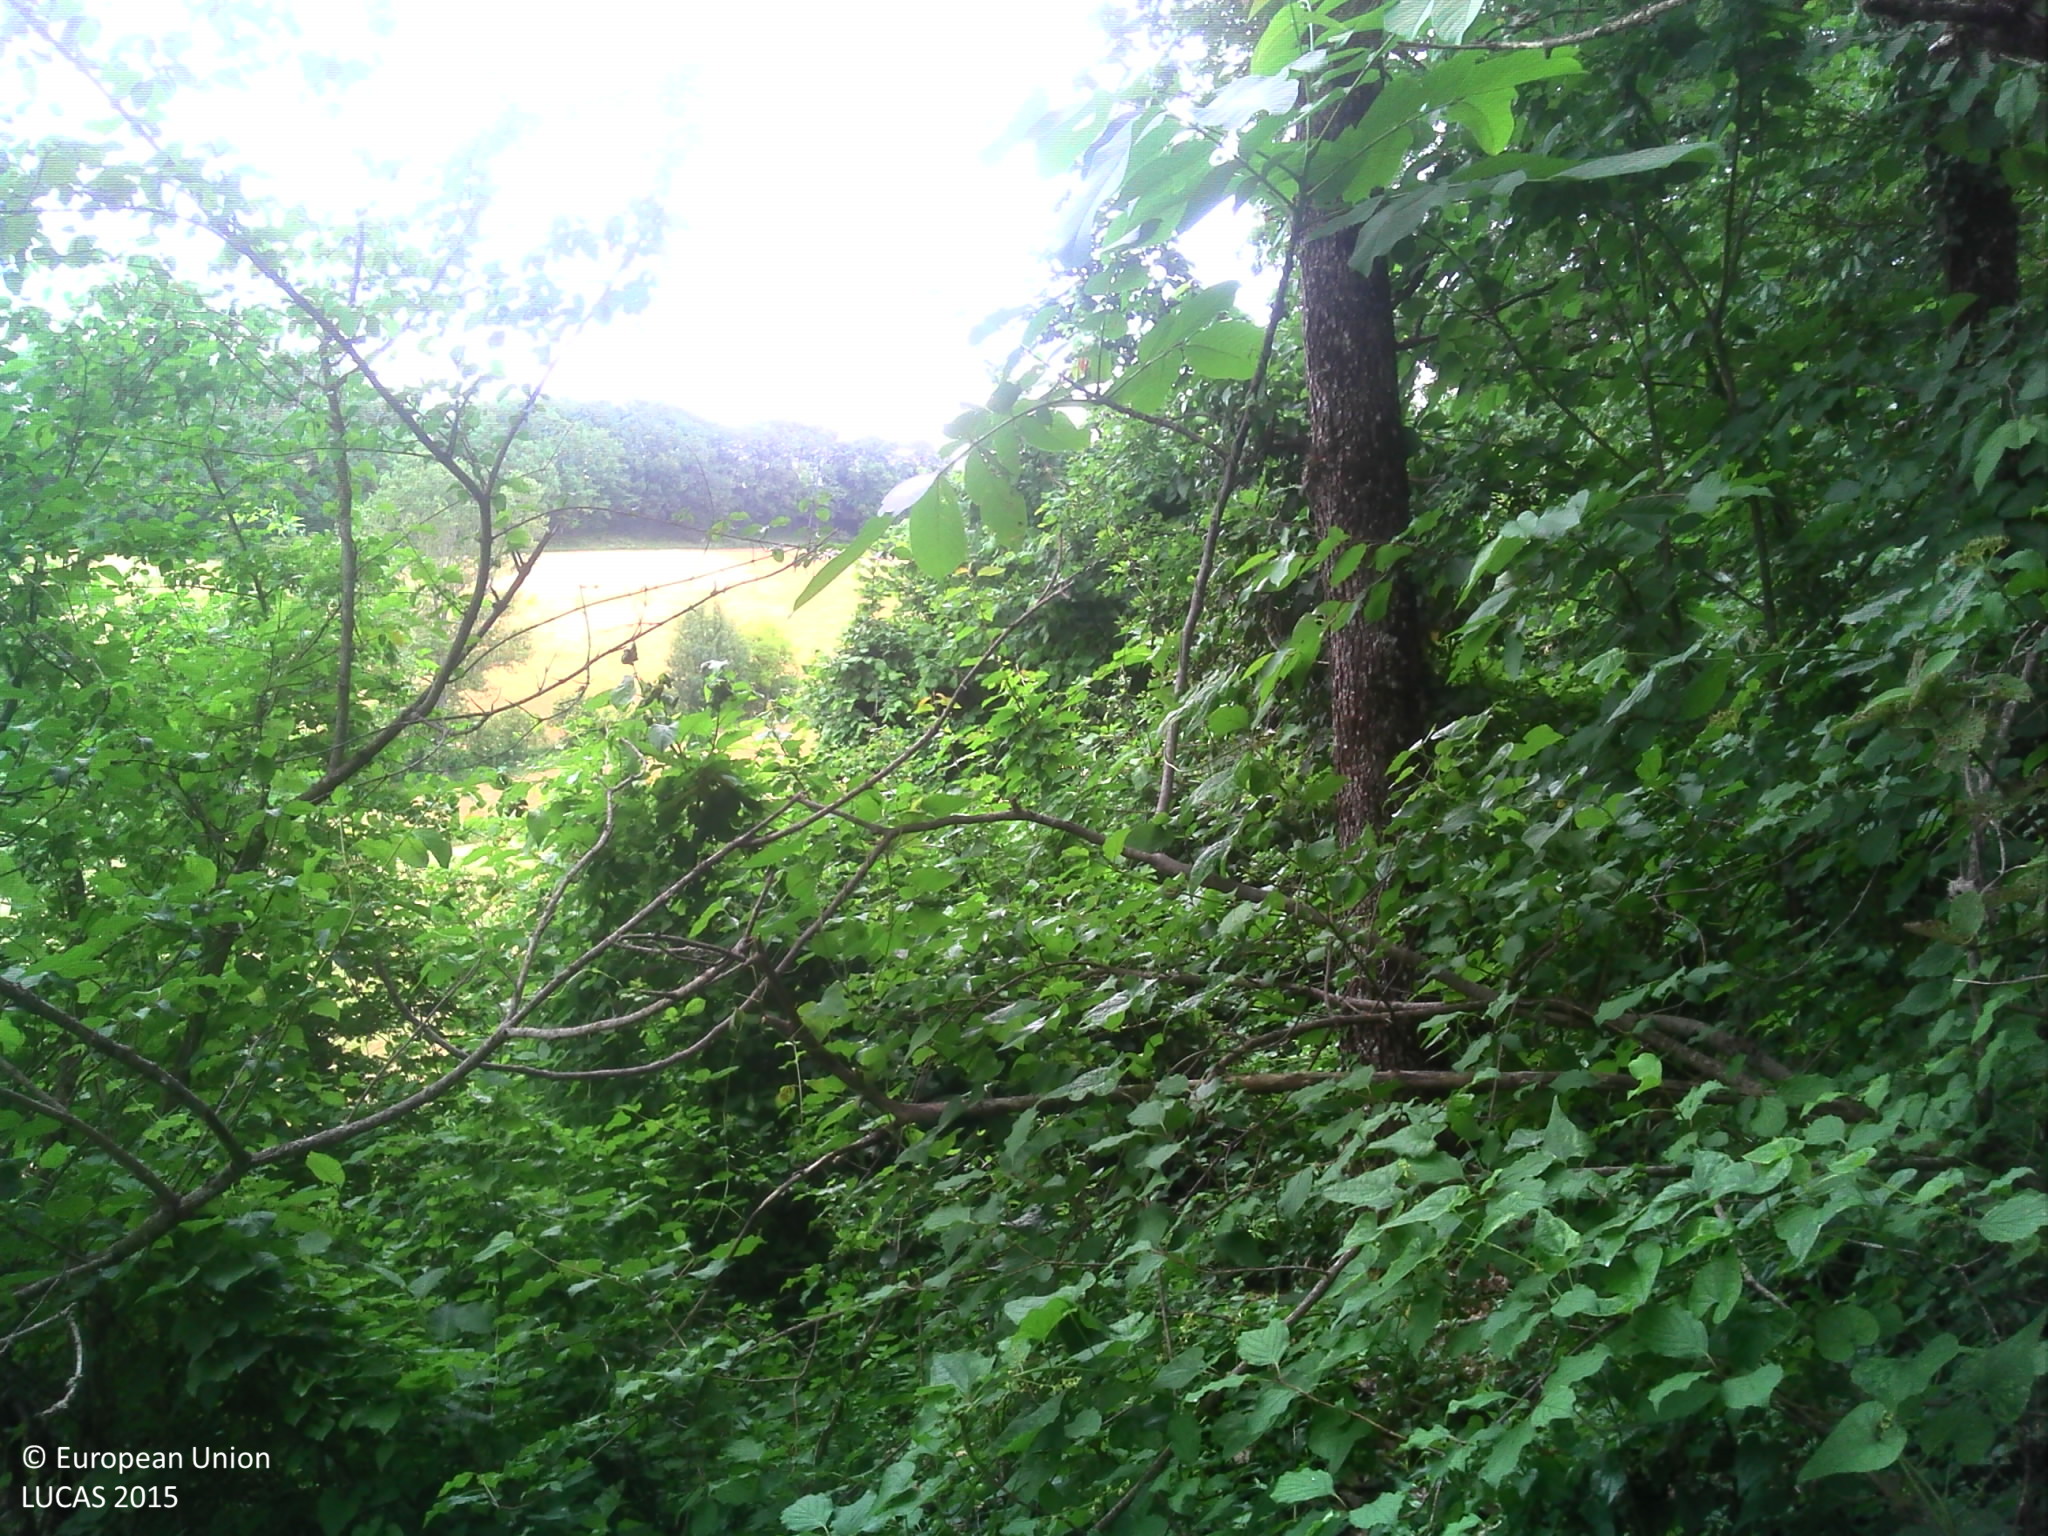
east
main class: Woodland
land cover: Broadleaved woodland
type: mesophytic deciduous forest
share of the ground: > 75 %
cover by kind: broadleaved forest trees 100 %
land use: Forestry
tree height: > 5 m
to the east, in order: Broadleaved woodland; Temporary grasslands; Abandoned hedges; Sunflower; Abandoned hedges; Ditches and canals; Sunflower
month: June
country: FR
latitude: 43.7246
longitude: 2.1221
